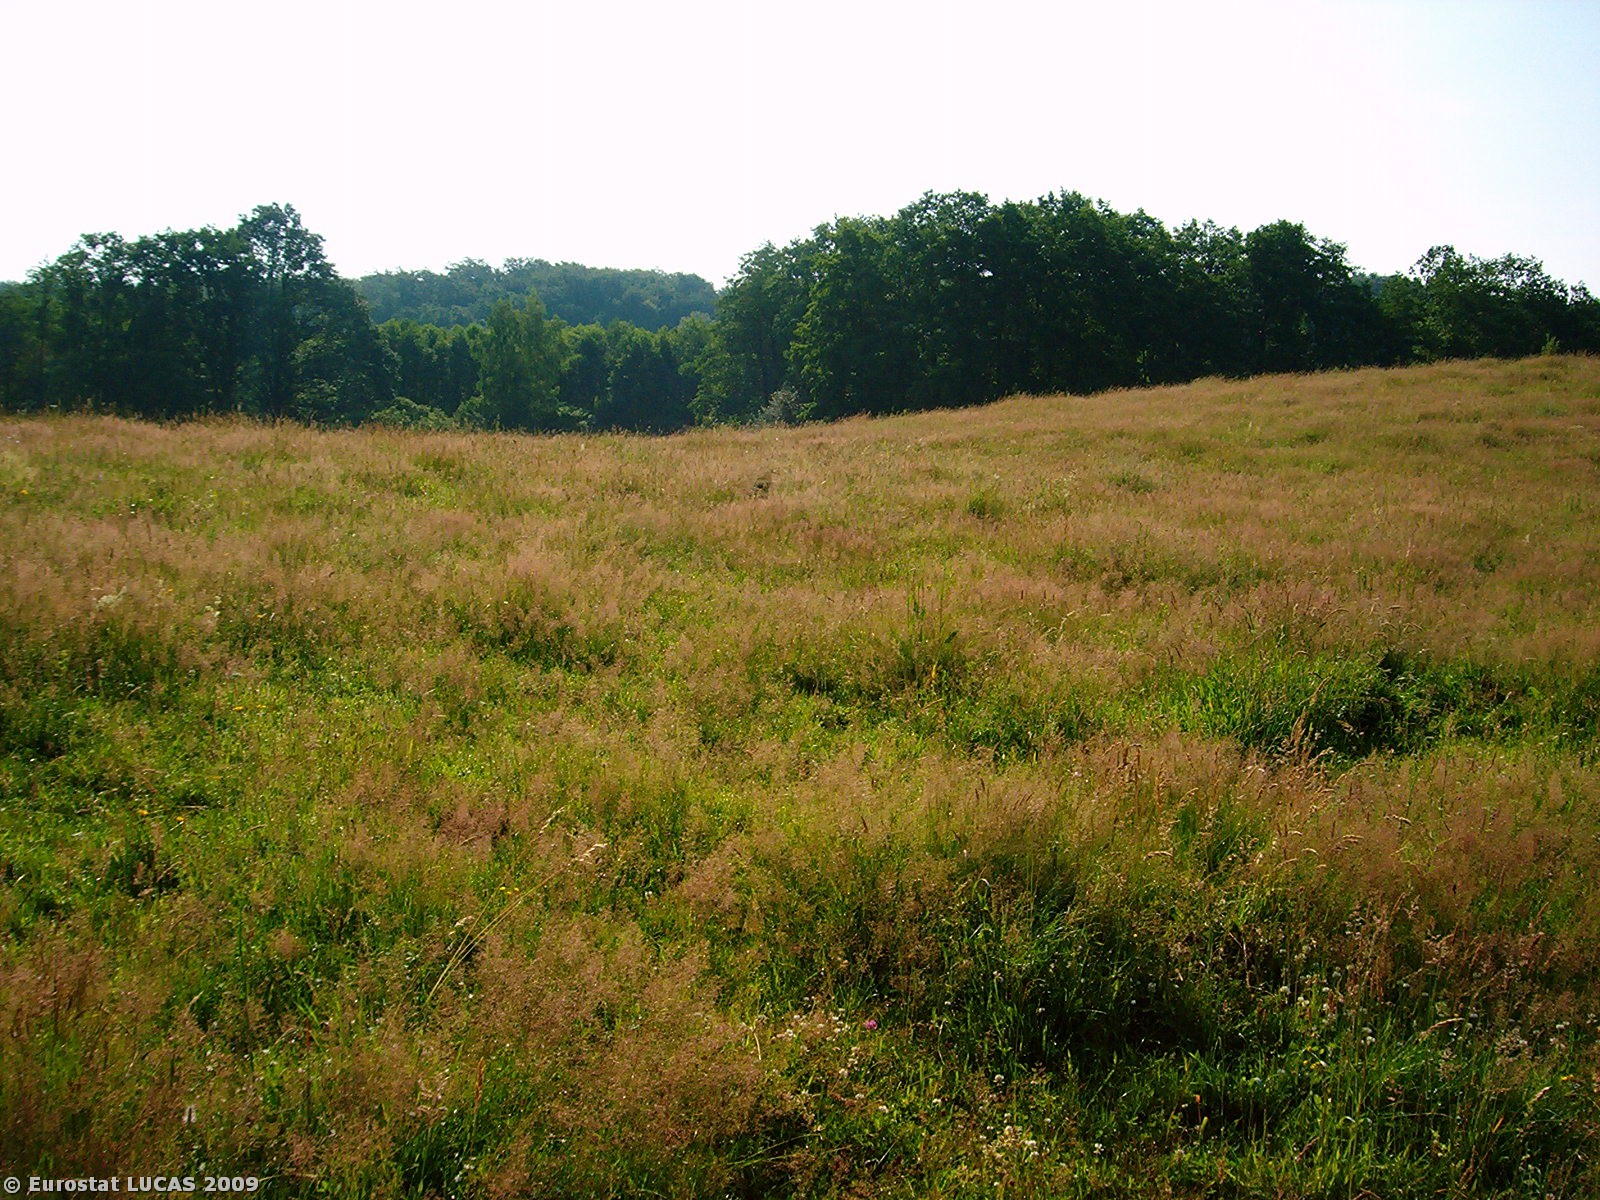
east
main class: Grassland
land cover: Grassland without tree/shrub cover
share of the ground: > 75 %
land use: Agriculture (excluding fallow land and kitchen gardens)
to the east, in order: Grassland without tree/shrub cover; Broadleaved woodland; Peatbogs; Broadleaved woodland
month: July
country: PL
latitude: 53.3855
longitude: 15.4911
